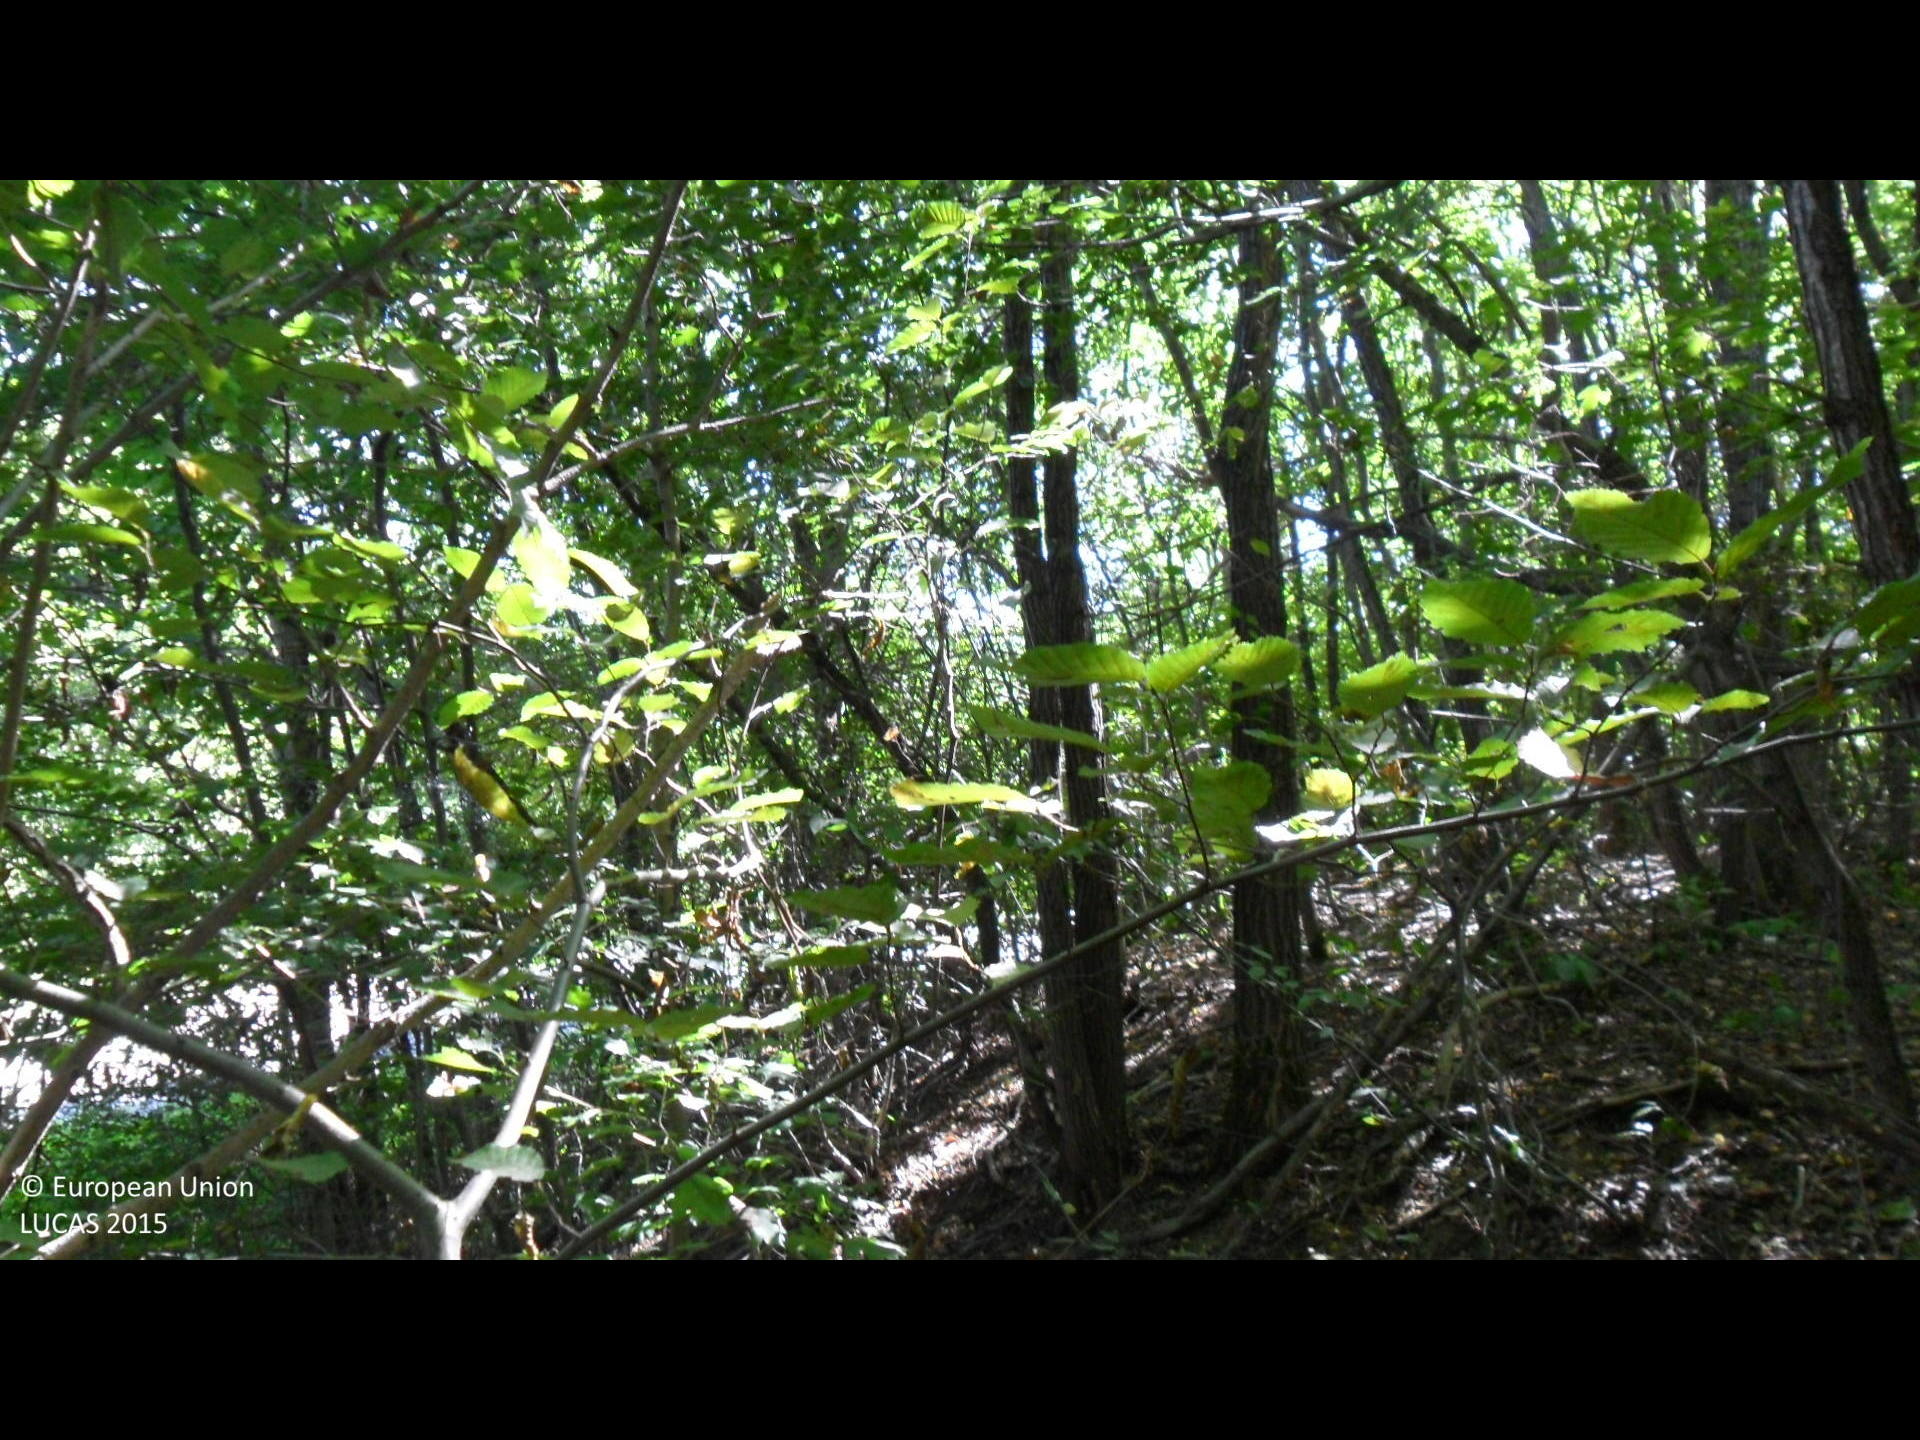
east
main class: Woodland
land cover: Broadleaved woodland
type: beech forest
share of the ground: > 75 %
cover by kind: broadleaved forest trees 95 %, unconsolidated bare surface 5 %
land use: Forestry
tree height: > 5 m
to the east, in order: Broadleaved woodland; Grass margins; Paved roads, cycling and walking lanes; Grass margins; Broadleaved woodland
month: September
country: BG
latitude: 43.1508
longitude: 26.3659
